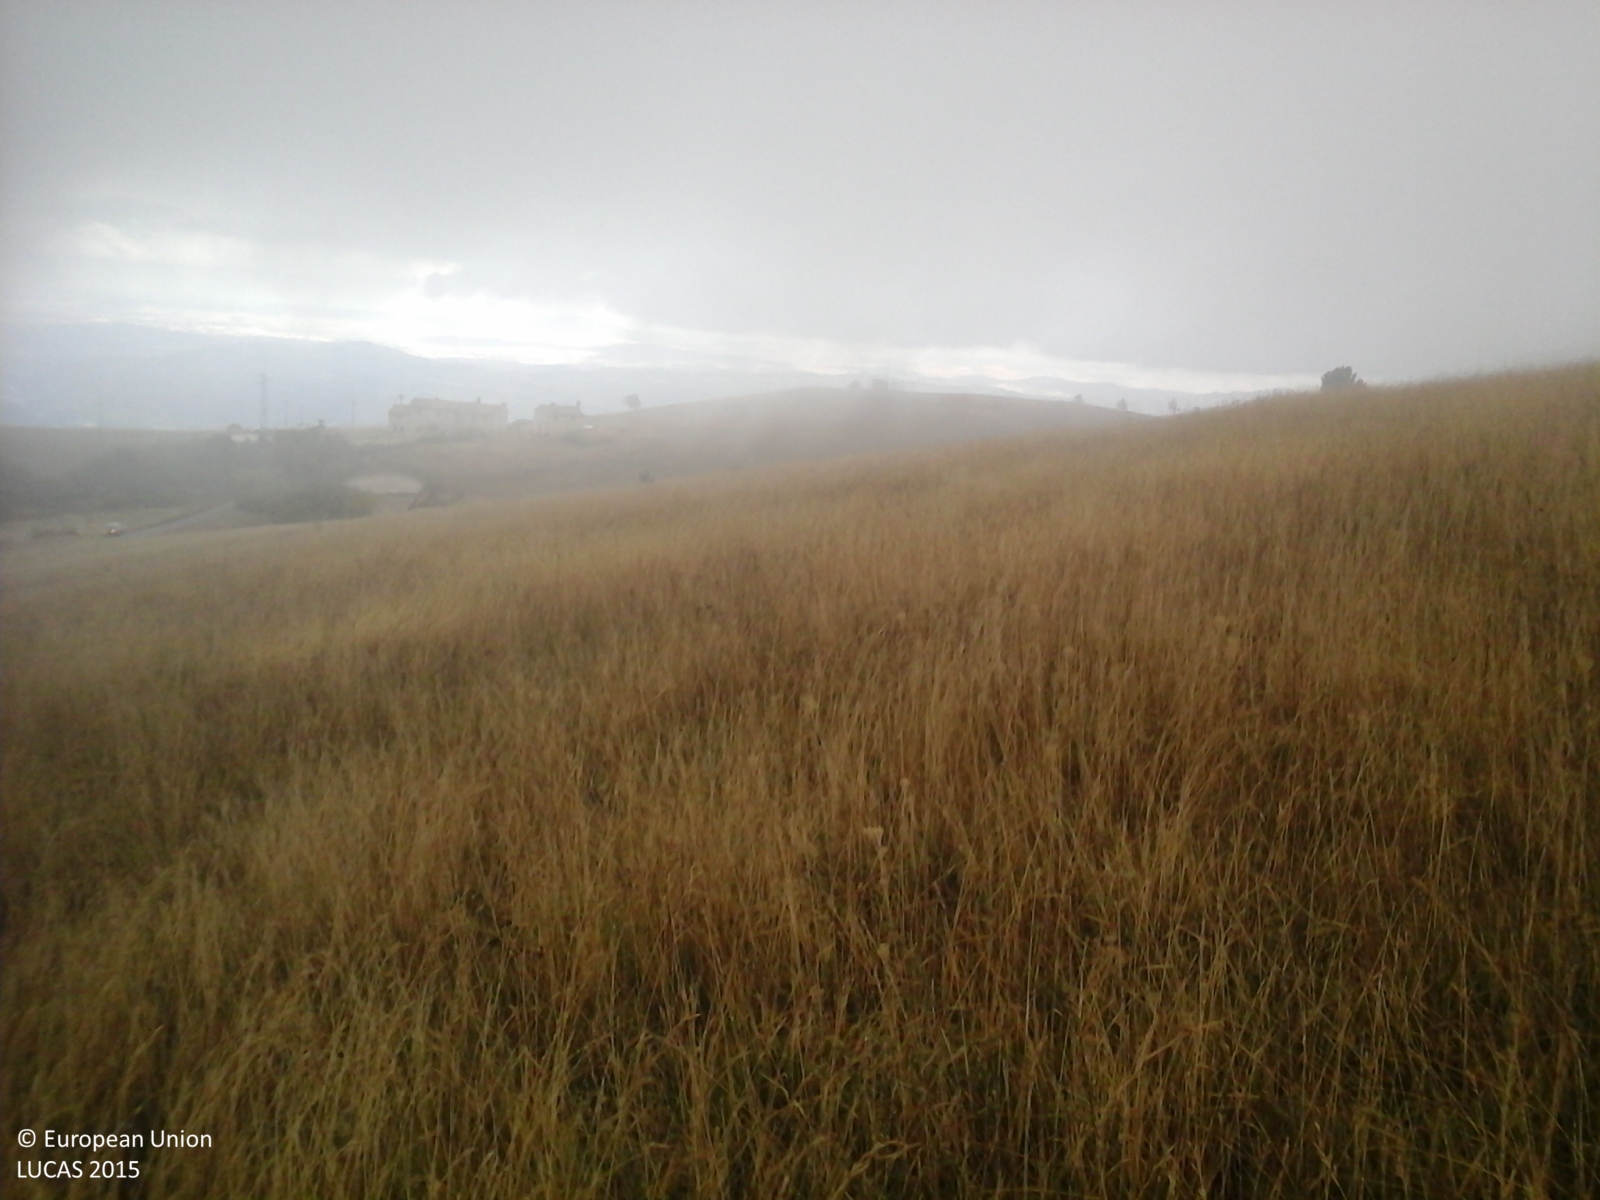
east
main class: Grassland
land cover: Grassland without tree/shrub cover
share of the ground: > 75 %
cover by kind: herbaceous plants 100 %
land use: Agriculture (excluding fallow land and kitchen gardens)
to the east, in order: Grassland without tree/shrub cover; Paved roads, cycling and walking lanes; Grass margins; Abandoned hedges; Grassland without tree/shrub cover; Electric lines; Grassland without tree/shrub cover
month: September
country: IT
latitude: 43.4408
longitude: 12.9947
